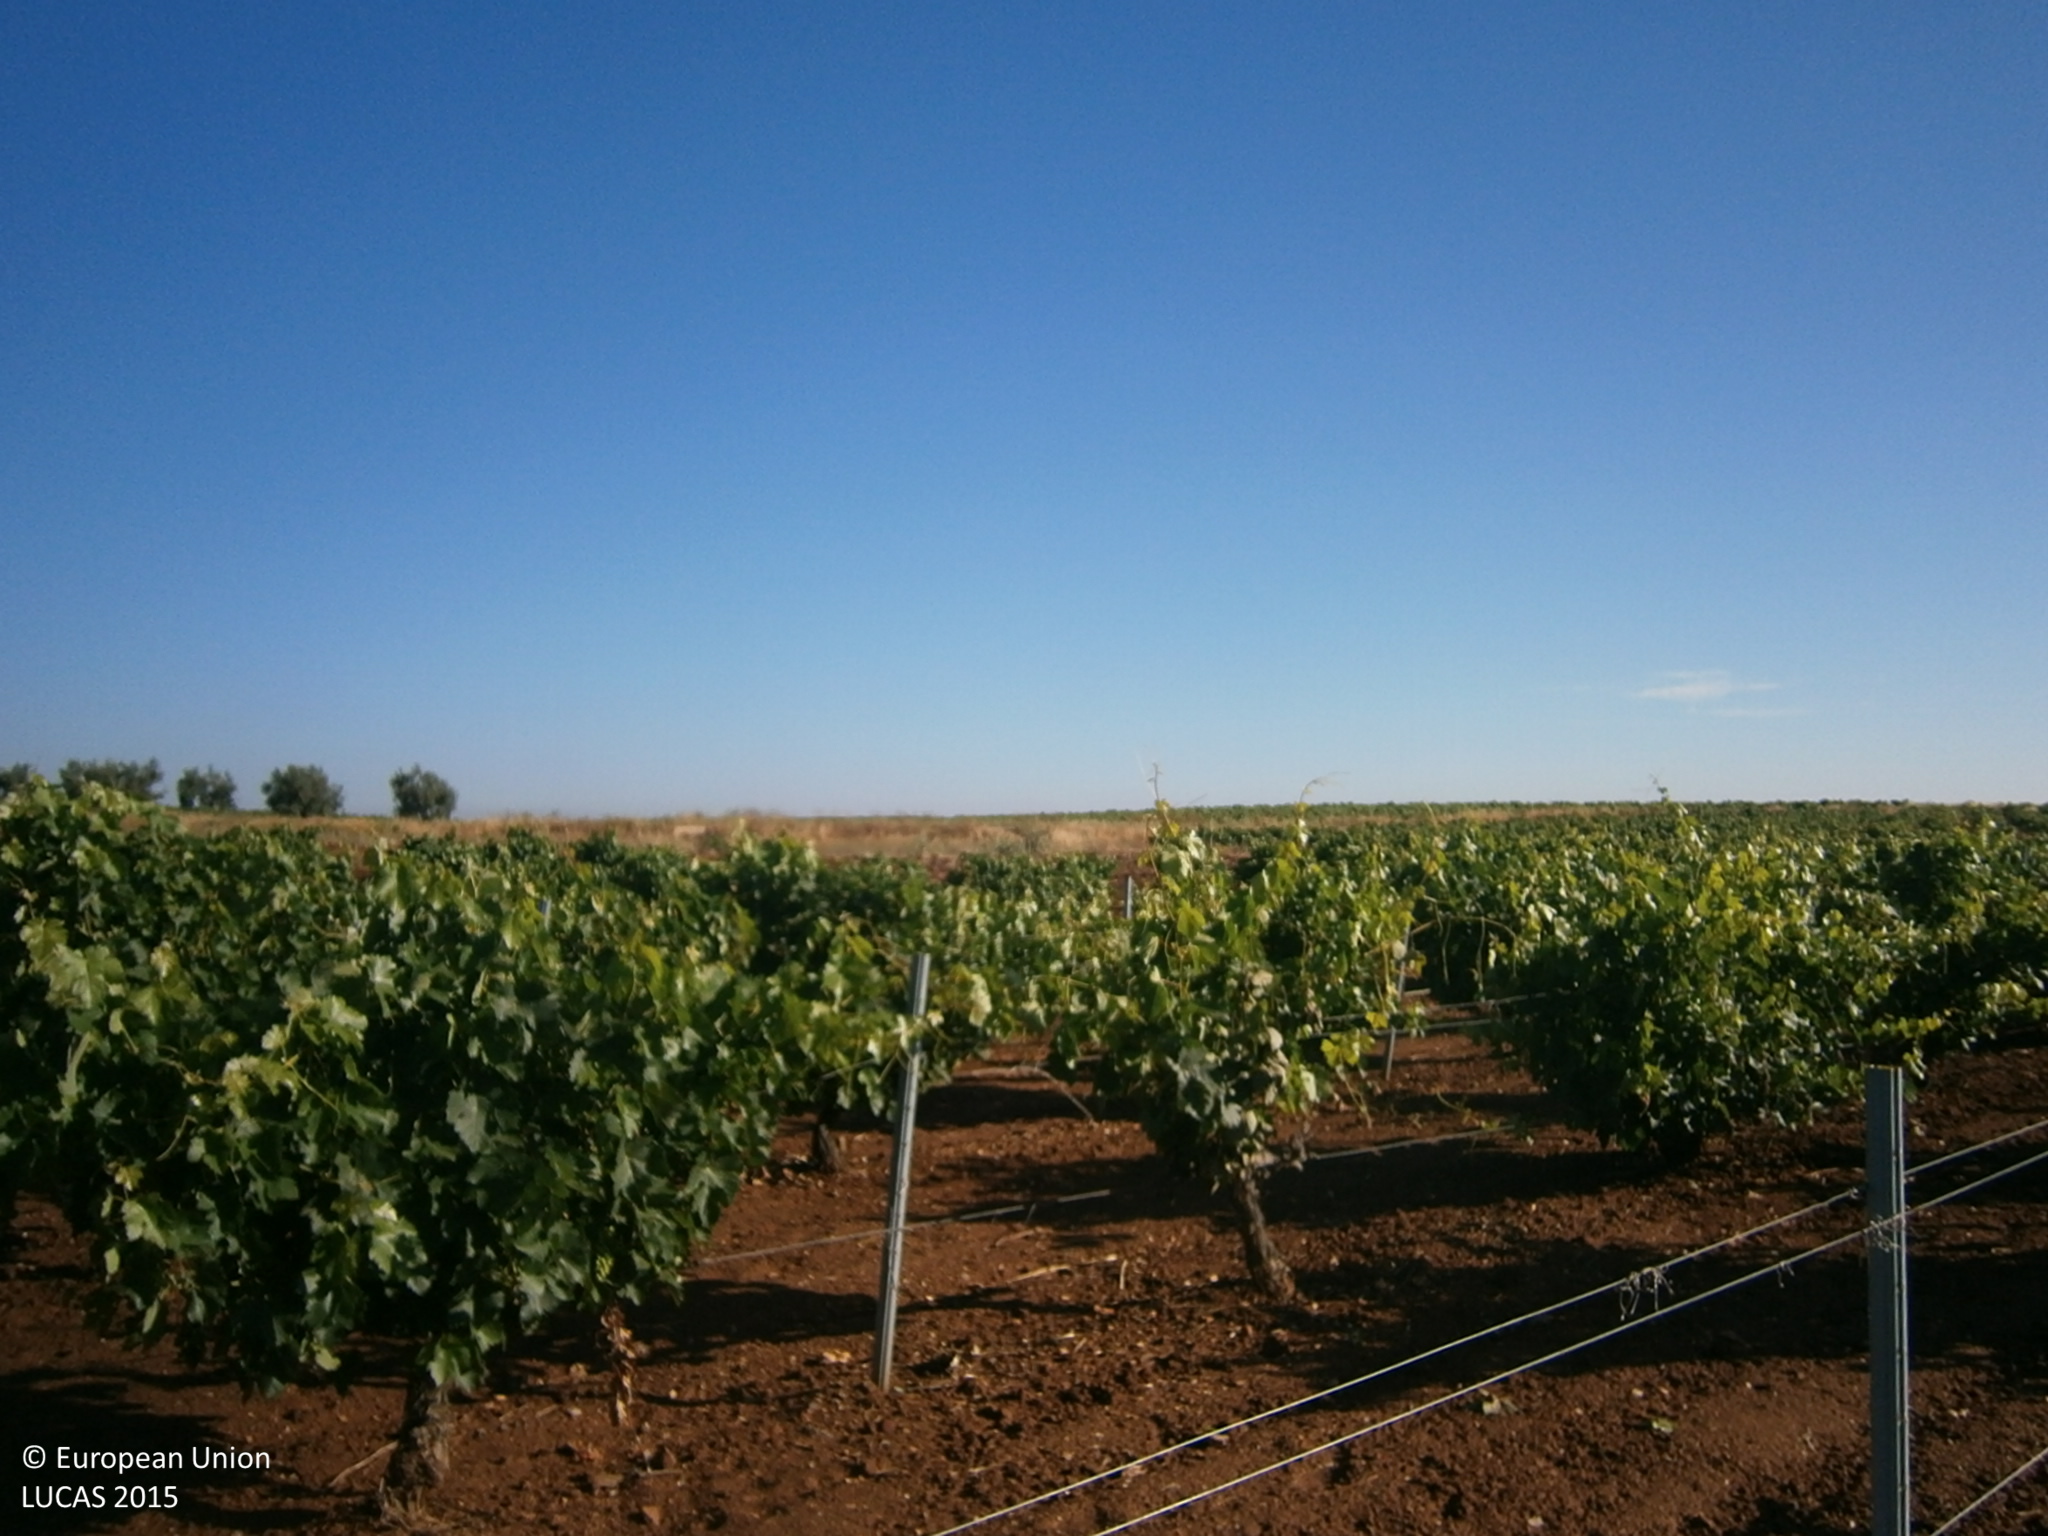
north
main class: Cropland
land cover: Vineyards
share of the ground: 25 - 50 %
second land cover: Other bare soil
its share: > 75 %
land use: Agriculture (excluding fallow land and kitchen gardens)
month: June
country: ES
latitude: 38.7213
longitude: -6.4461
